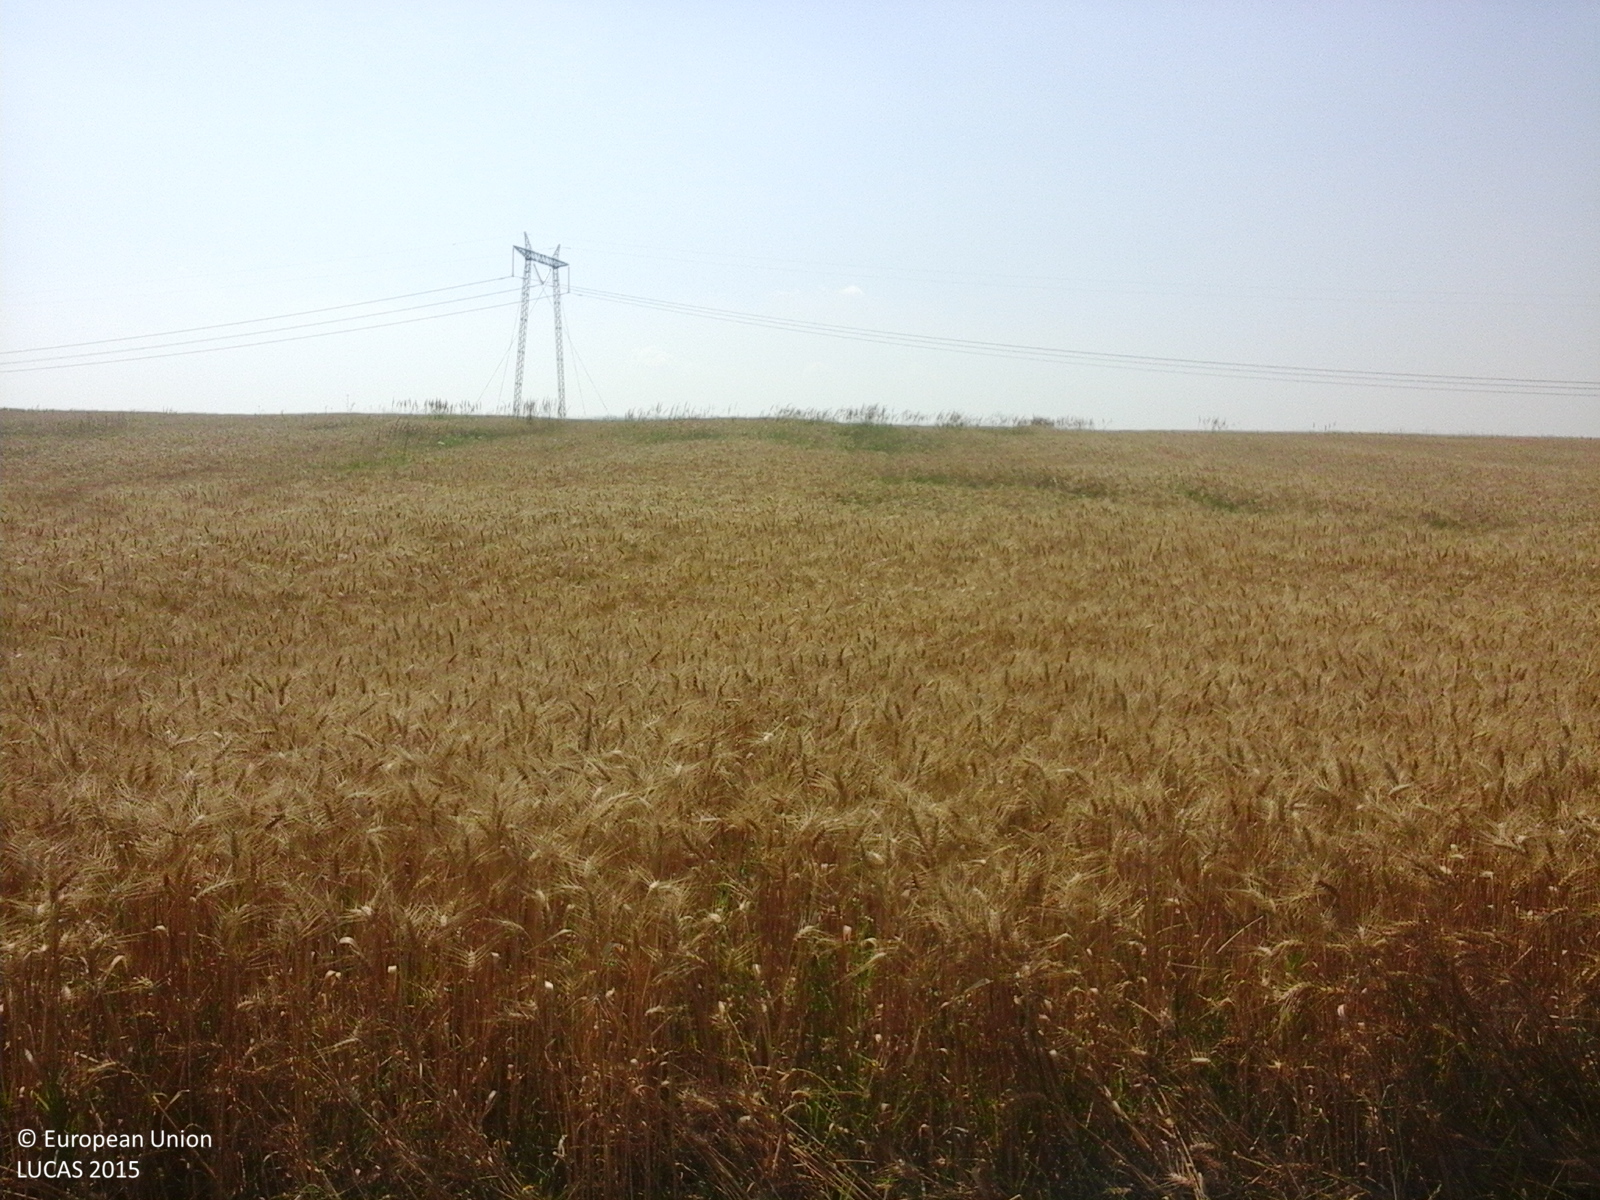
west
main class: Cropland
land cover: Common wheat
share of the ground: > 75 %
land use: Agriculture (excluding fallow land and kitchen gardens)
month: July
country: RO
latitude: 44.6809
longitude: 24.4927
